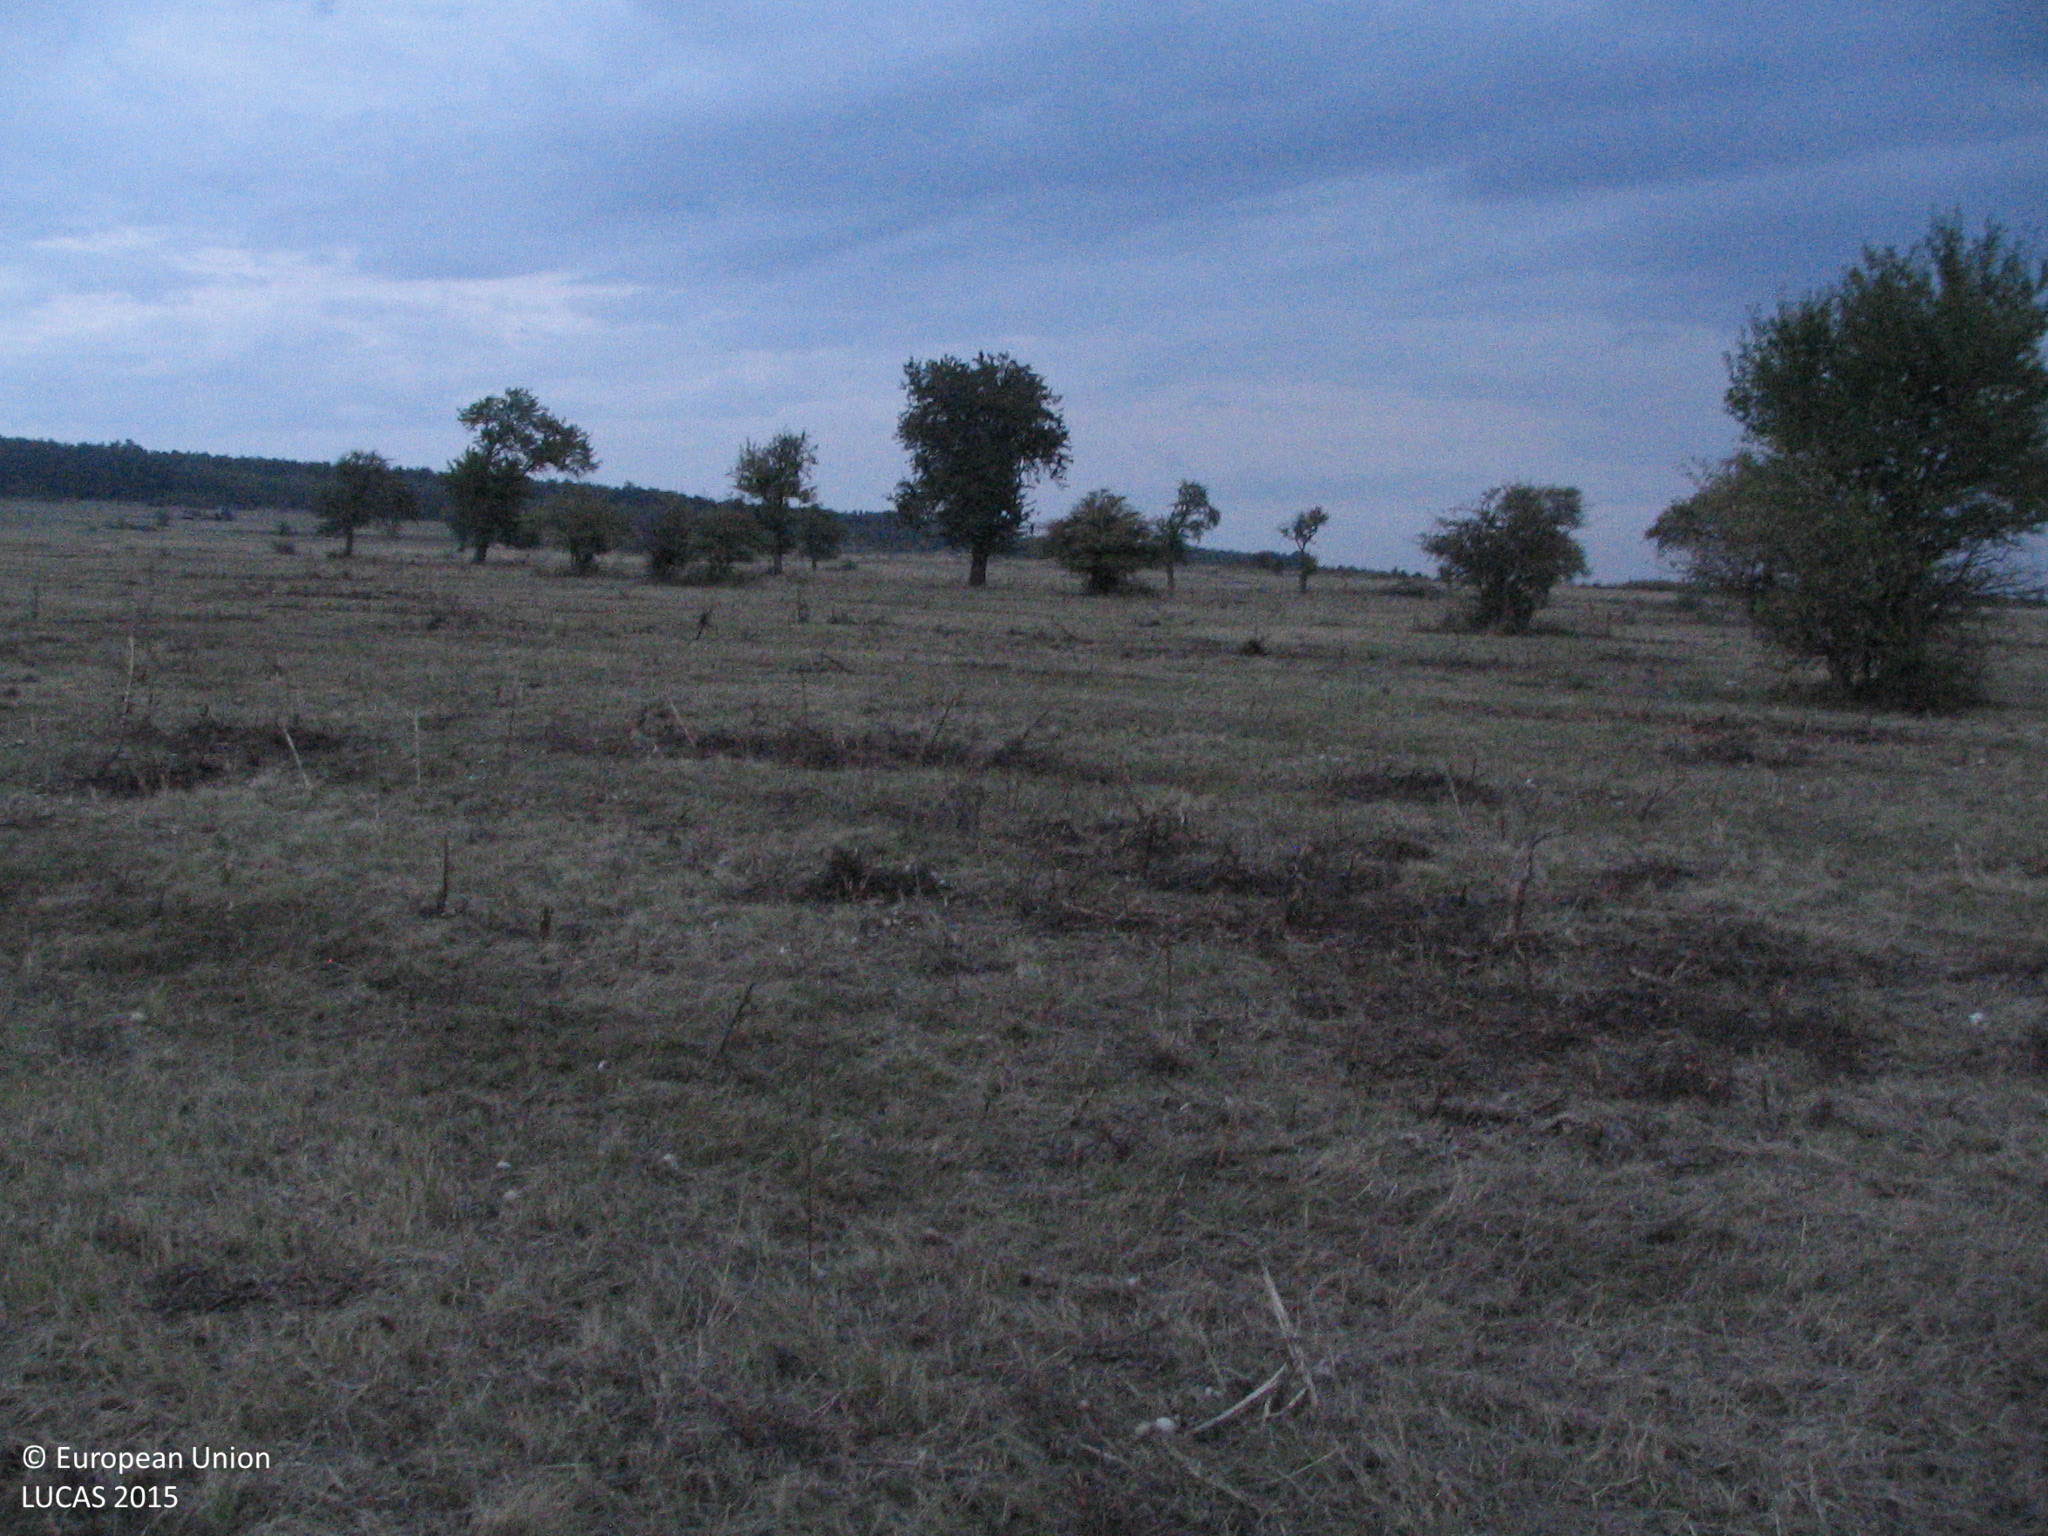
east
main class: Grassland
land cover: Grassland without tree/shrub cover
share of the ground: > 75 %
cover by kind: herbaceous plants 95 %, shrubs 5 %
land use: Agriculture (excluding fallow land and kitchen gardens)
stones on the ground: < 10 %
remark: Harvested field
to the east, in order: Grassland without tree/shrub cover; Grassland with sparse tree/shrub cover; Tracks; Grassland with sparse tree/shrub cover
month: October
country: BG
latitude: 43.3255
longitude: 23.8481
